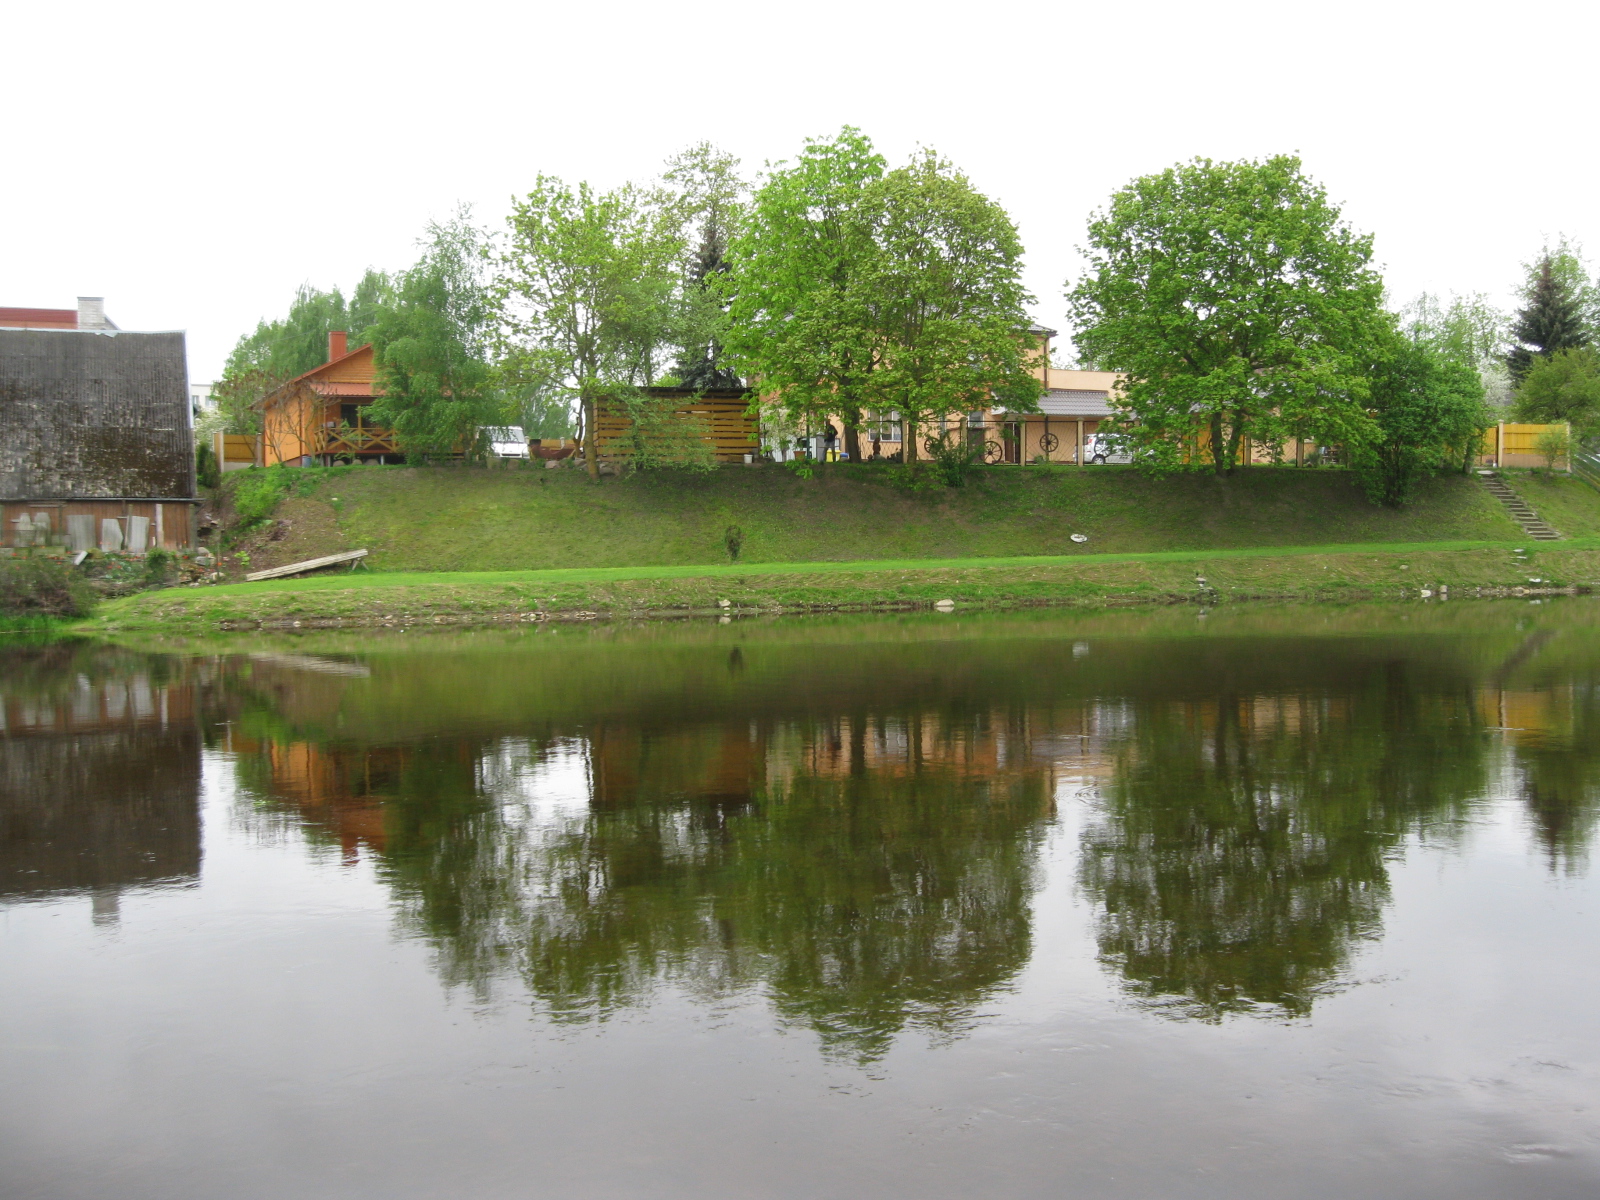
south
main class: Grassland
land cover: Grassland without tree/shrub cover
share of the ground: > 75 %
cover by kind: herbaceous plants 100 %
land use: Amenities, museums, leisure
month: May
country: LT
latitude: 56.0642
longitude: 24.4065
